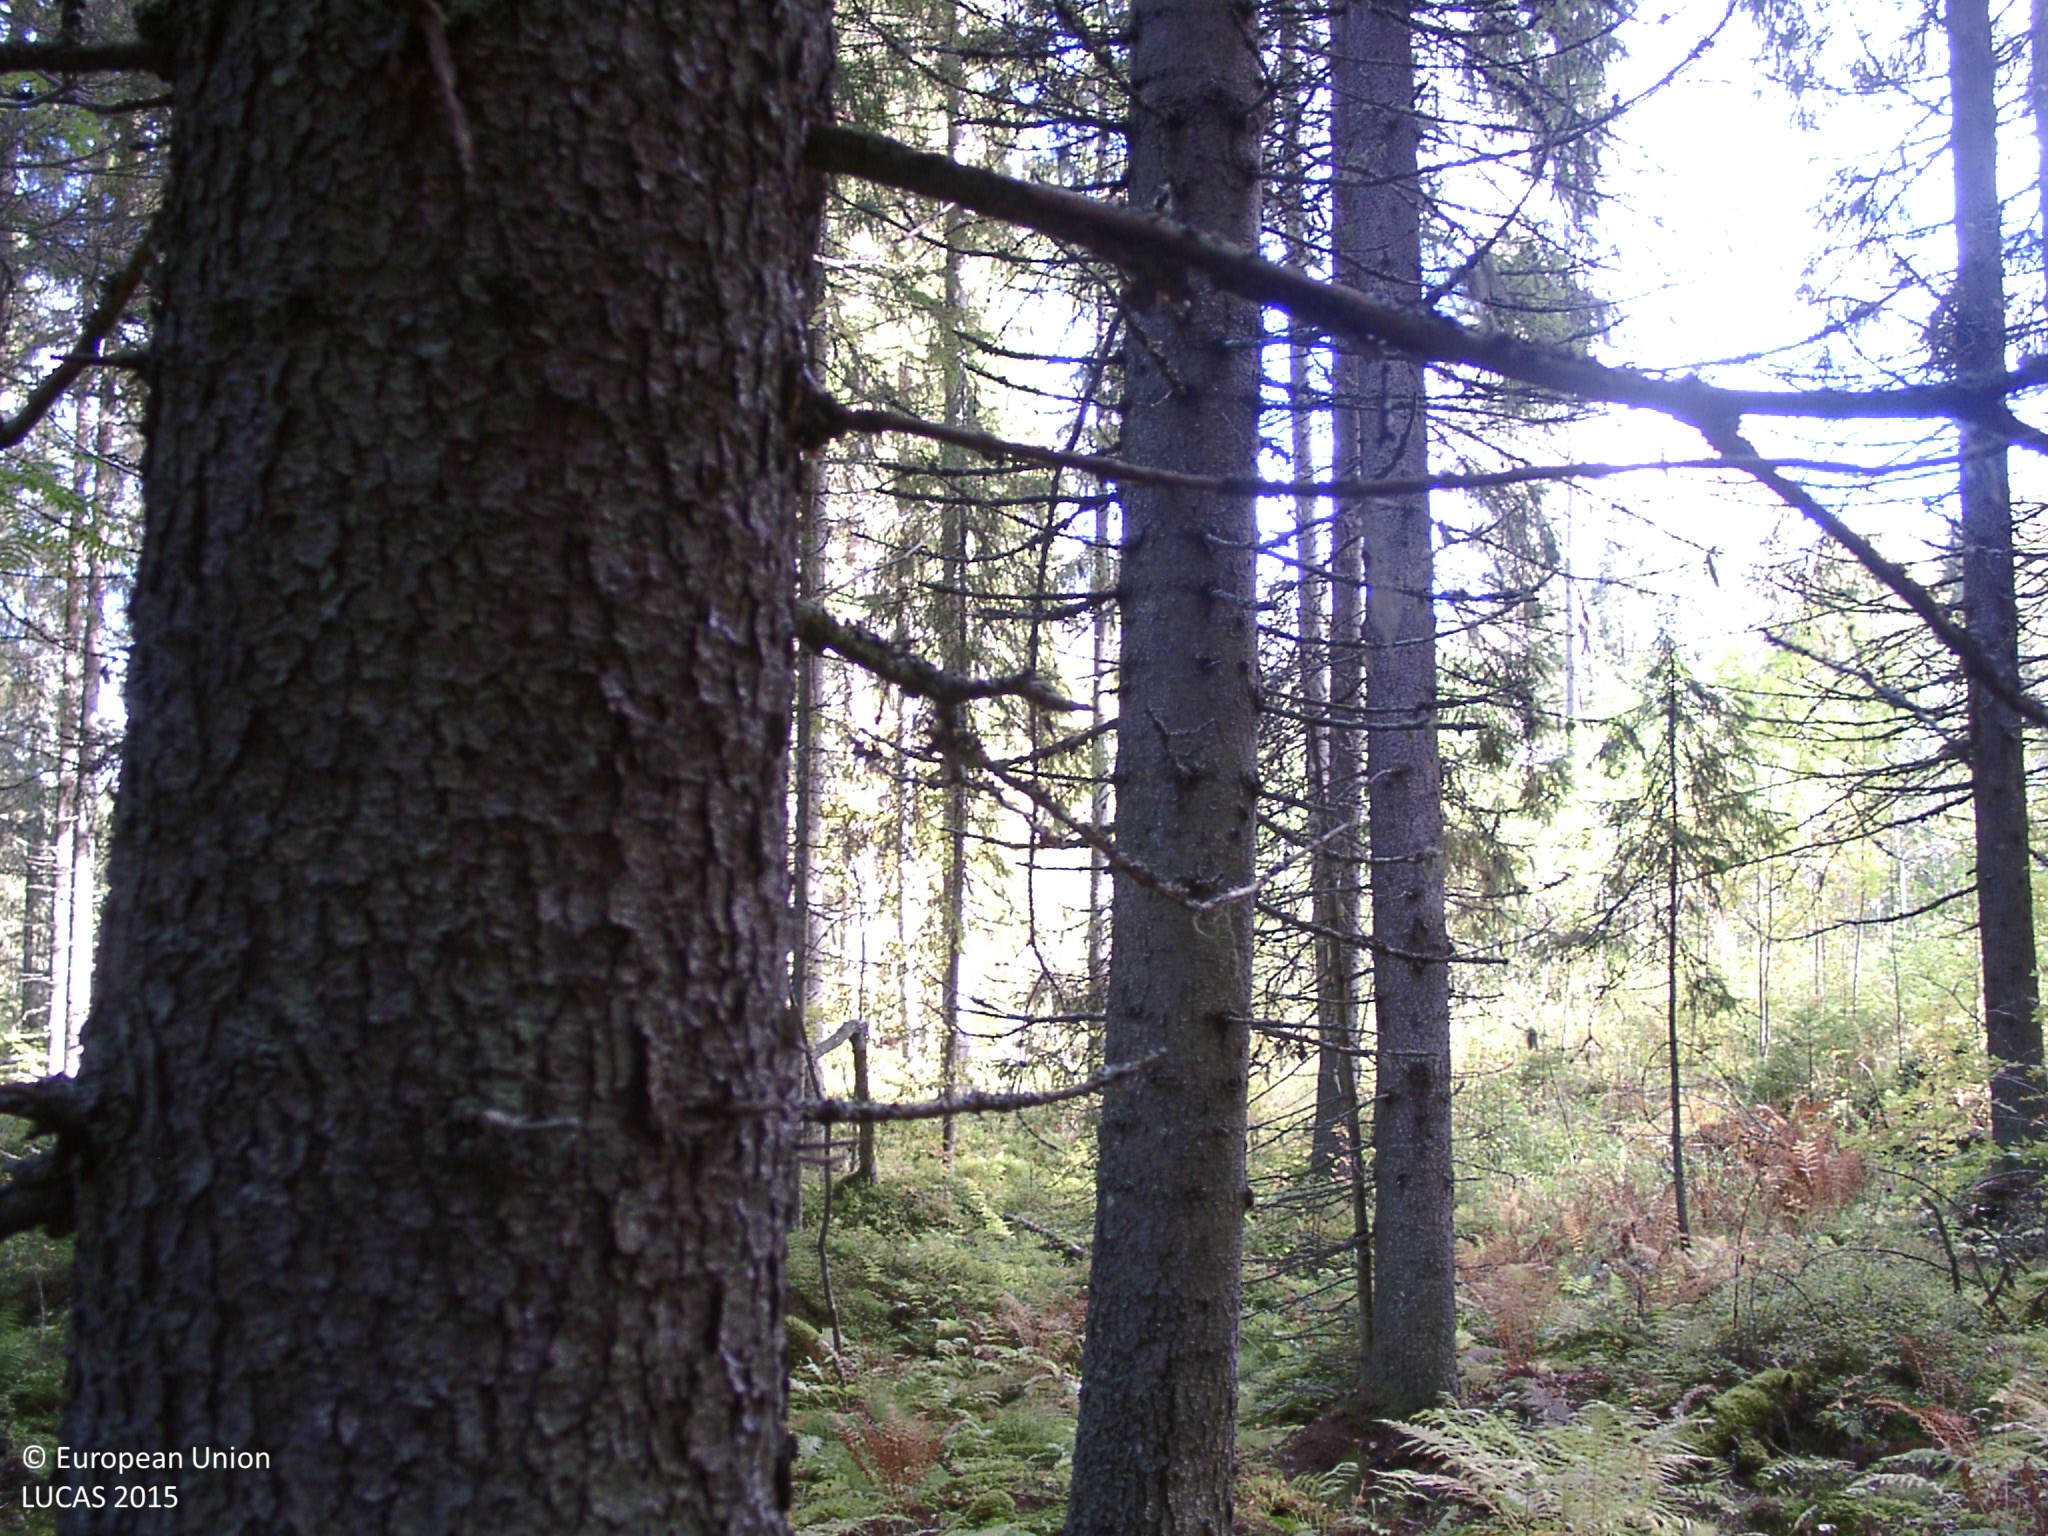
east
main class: Woodland
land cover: Spruce dominated coniferous woodland
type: boreal forest
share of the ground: > 75 %
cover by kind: coniferous forest trees 80 %, broadleaved forest trees 5 %, shrubs 5 %, herbaceous plants 5 %, lichens and mosses 5 %
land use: Forestry
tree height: > 5 m
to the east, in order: Spruce dominated coniferous woodland; Rivers and streams; Broadleaved woodland; Ditches and canals; Shruby margins; Tracks; Other mixed woodland; Broadleaved woodland; Other mixed woodland; Pine dominated mixed woodland
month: September
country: FI
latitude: 62.5397
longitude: 25.3275
